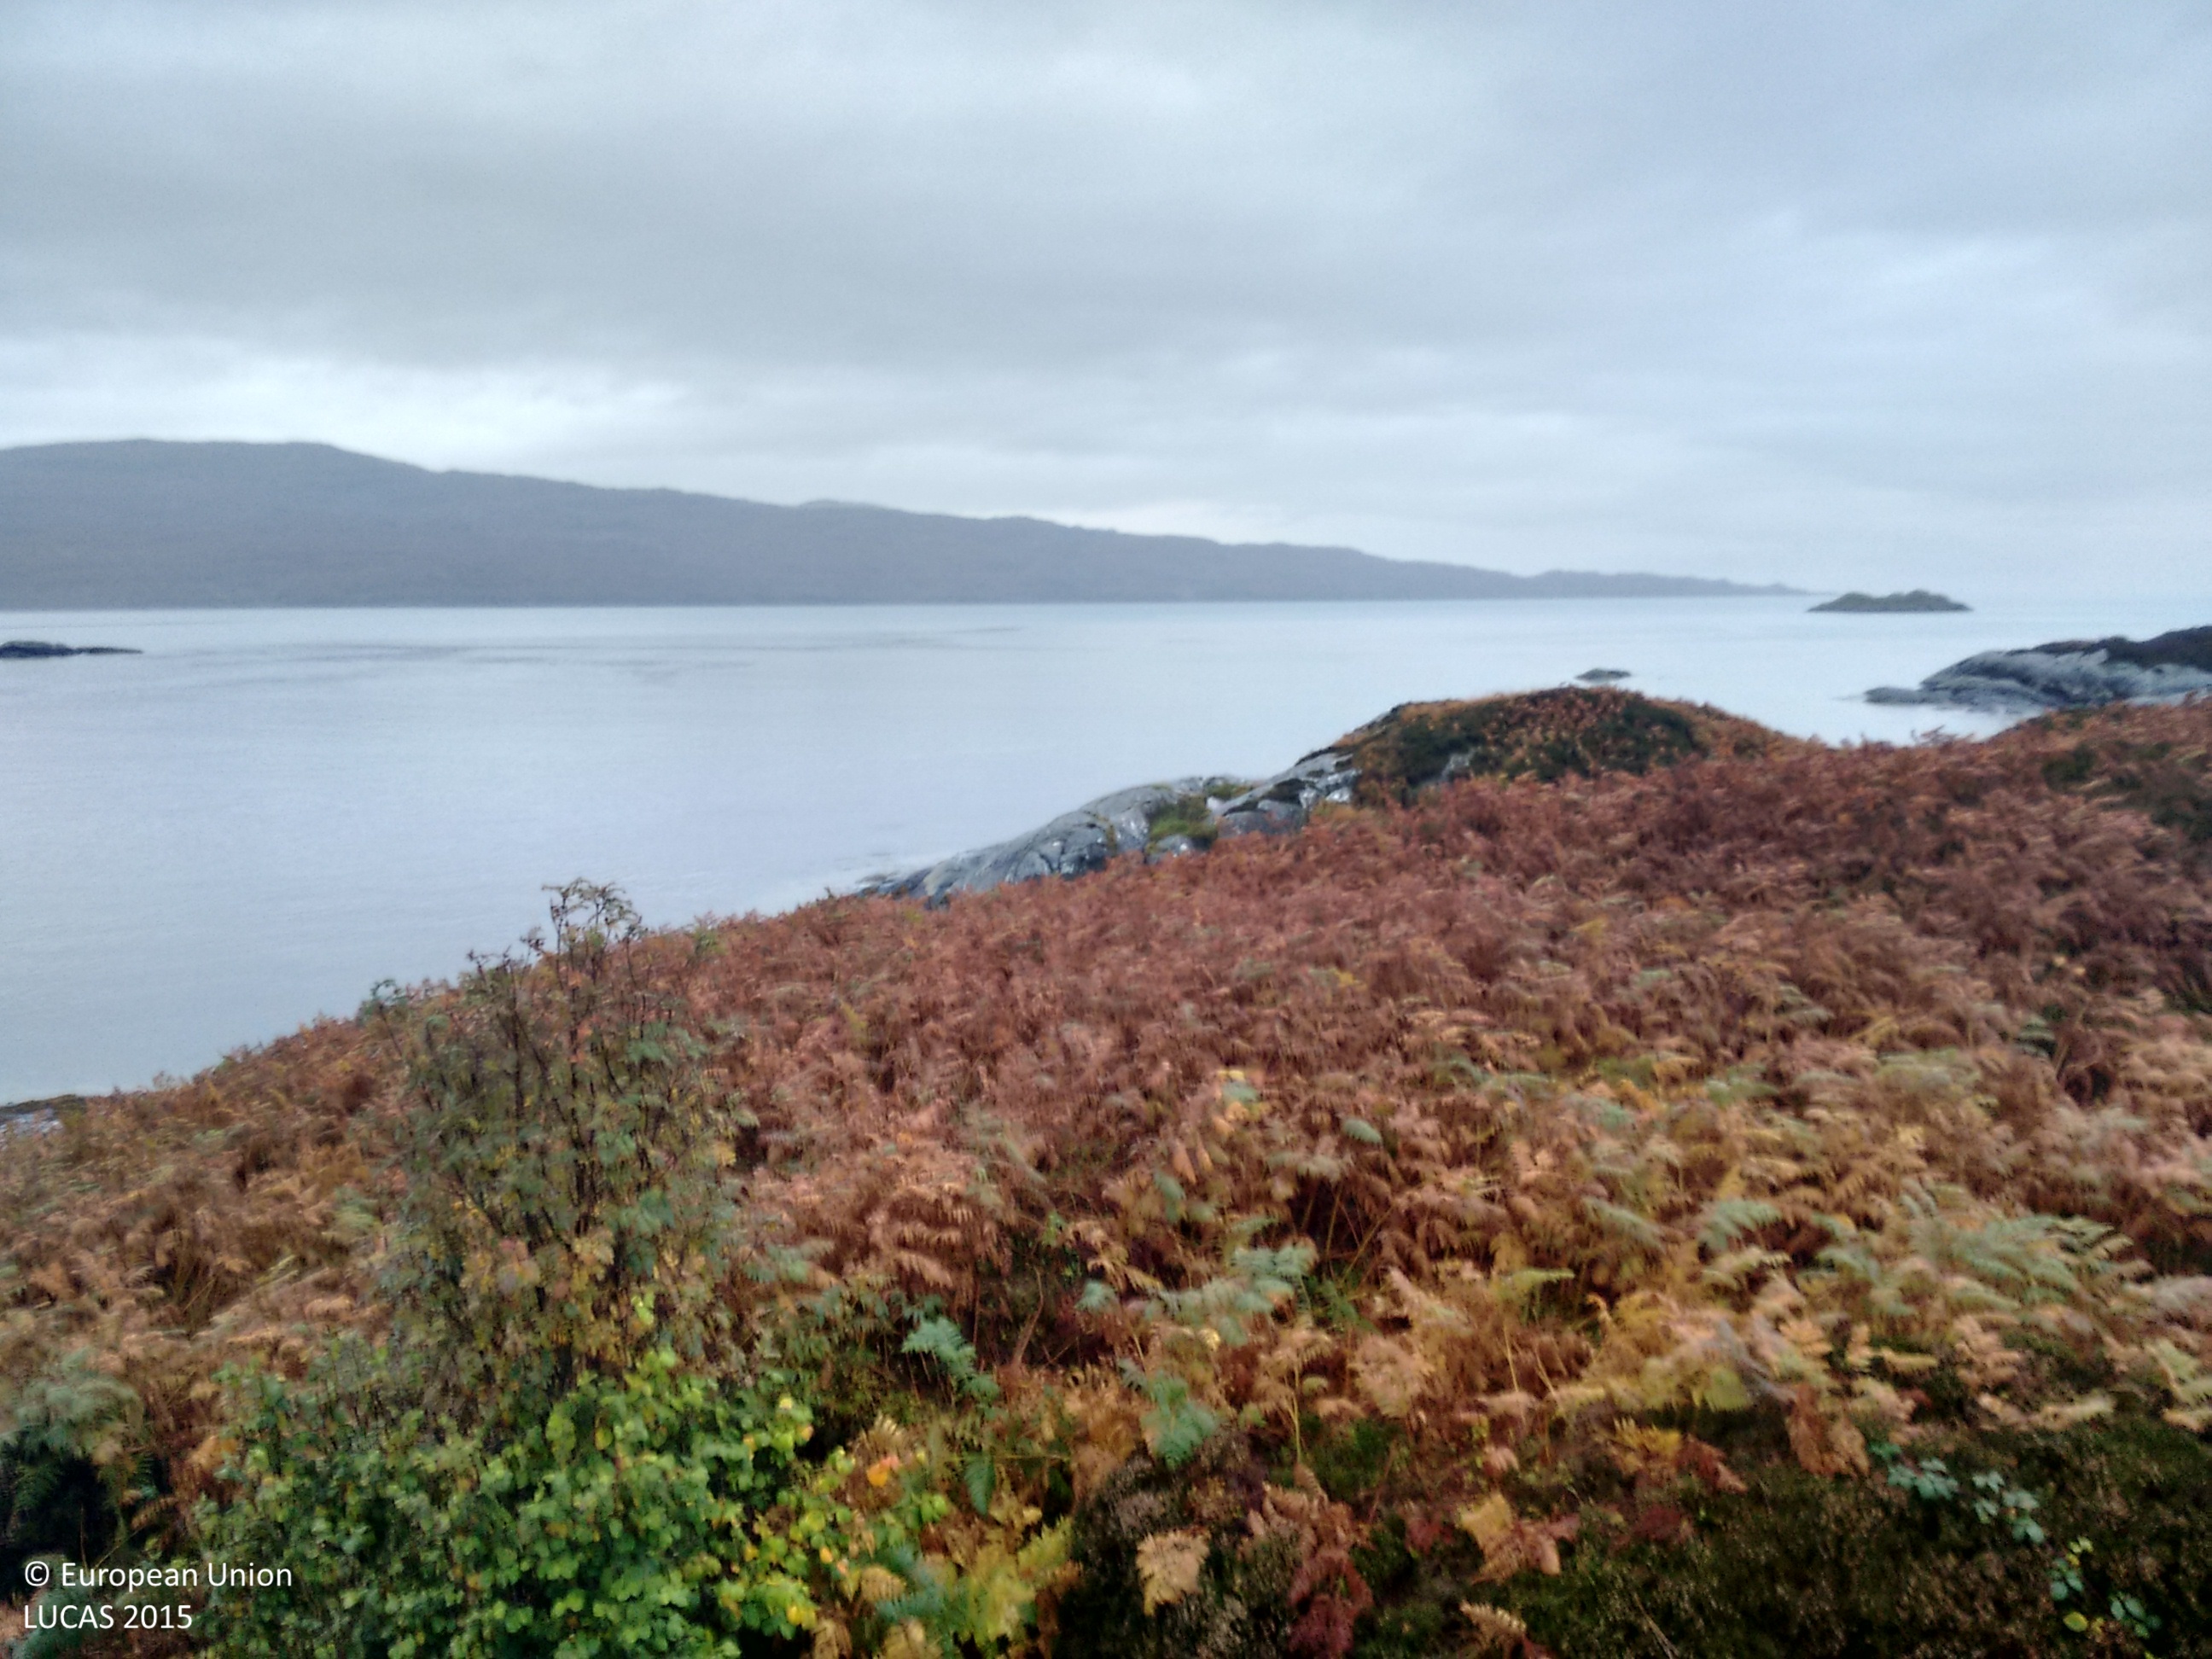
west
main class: Shrubland
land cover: Shrubland without tree cover
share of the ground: > 75 %
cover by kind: shrubs 50 %, herbaceous plants 30 %, consolidated bare surface 20 %
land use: Amenities, museums, leisure
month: October
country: GB
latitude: 56.7690
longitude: -5.8851
